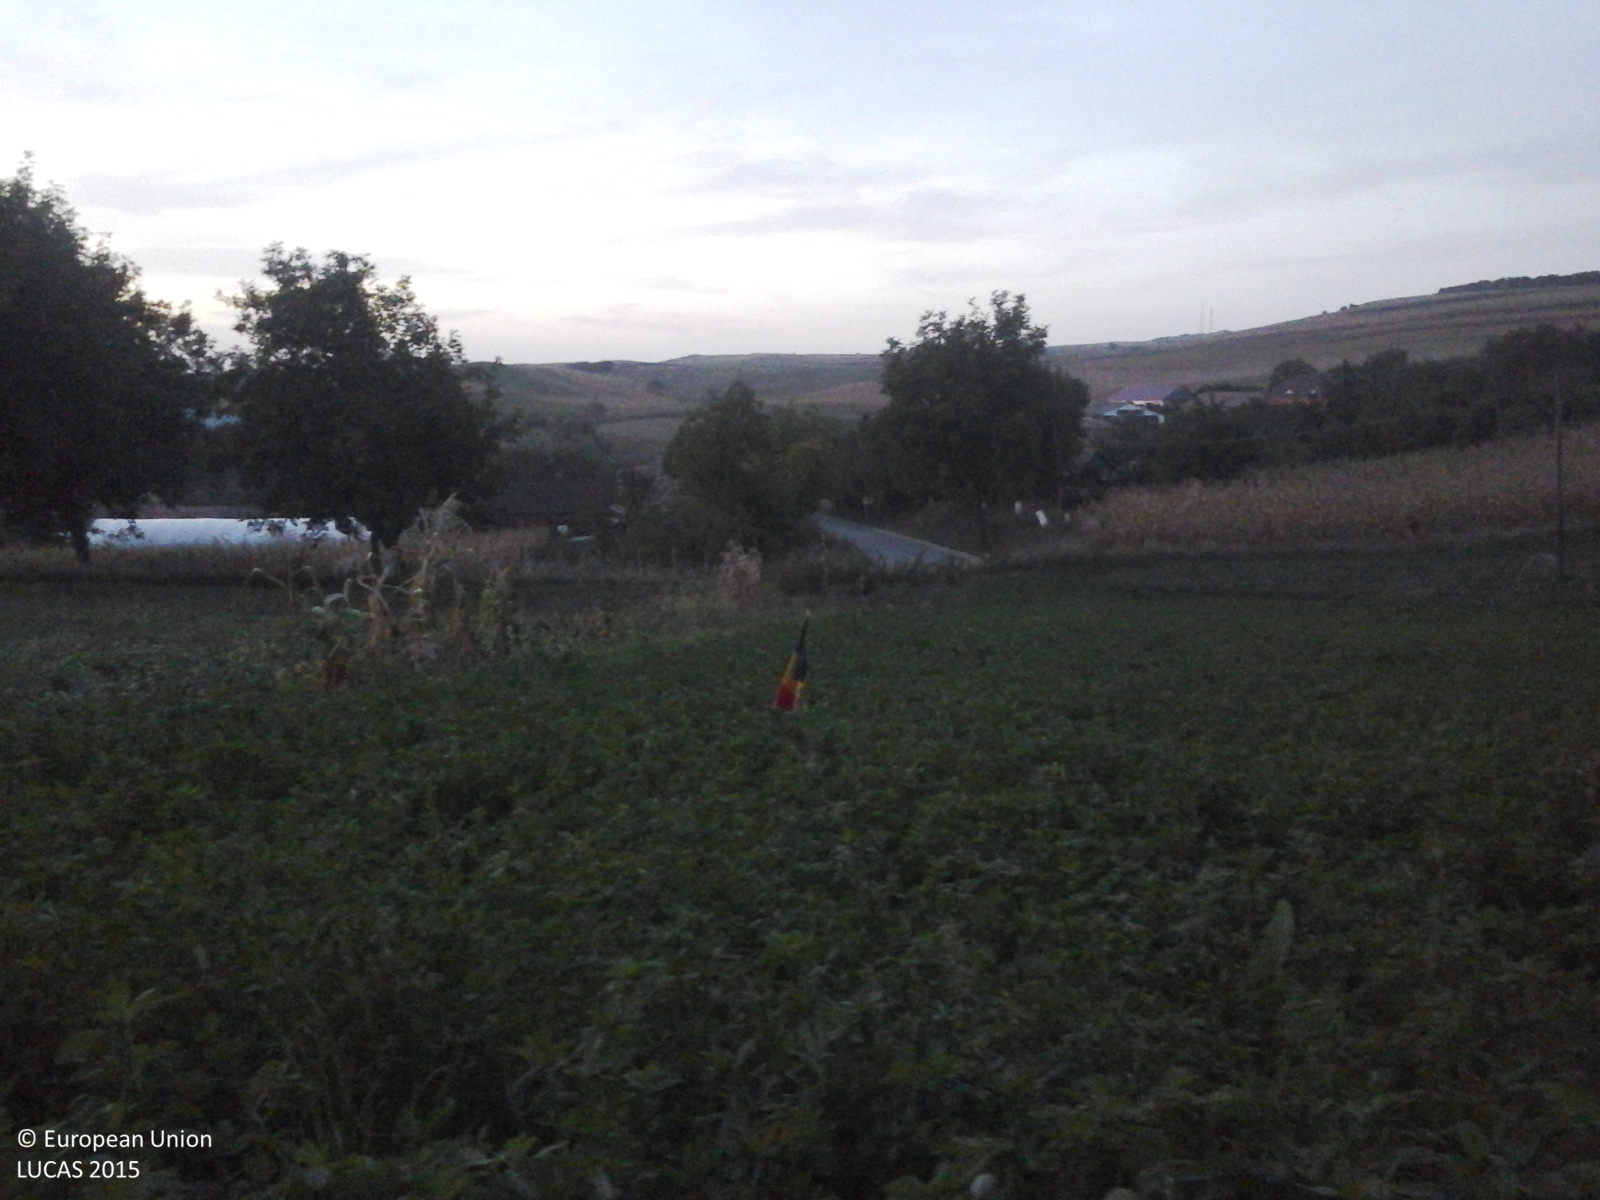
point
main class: Cropland
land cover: Lucerne
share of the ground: > 75 %
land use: Agriculture (excluding fallow land and kitchen gardens)
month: September
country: RO
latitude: 46.5969
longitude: 23.9790
